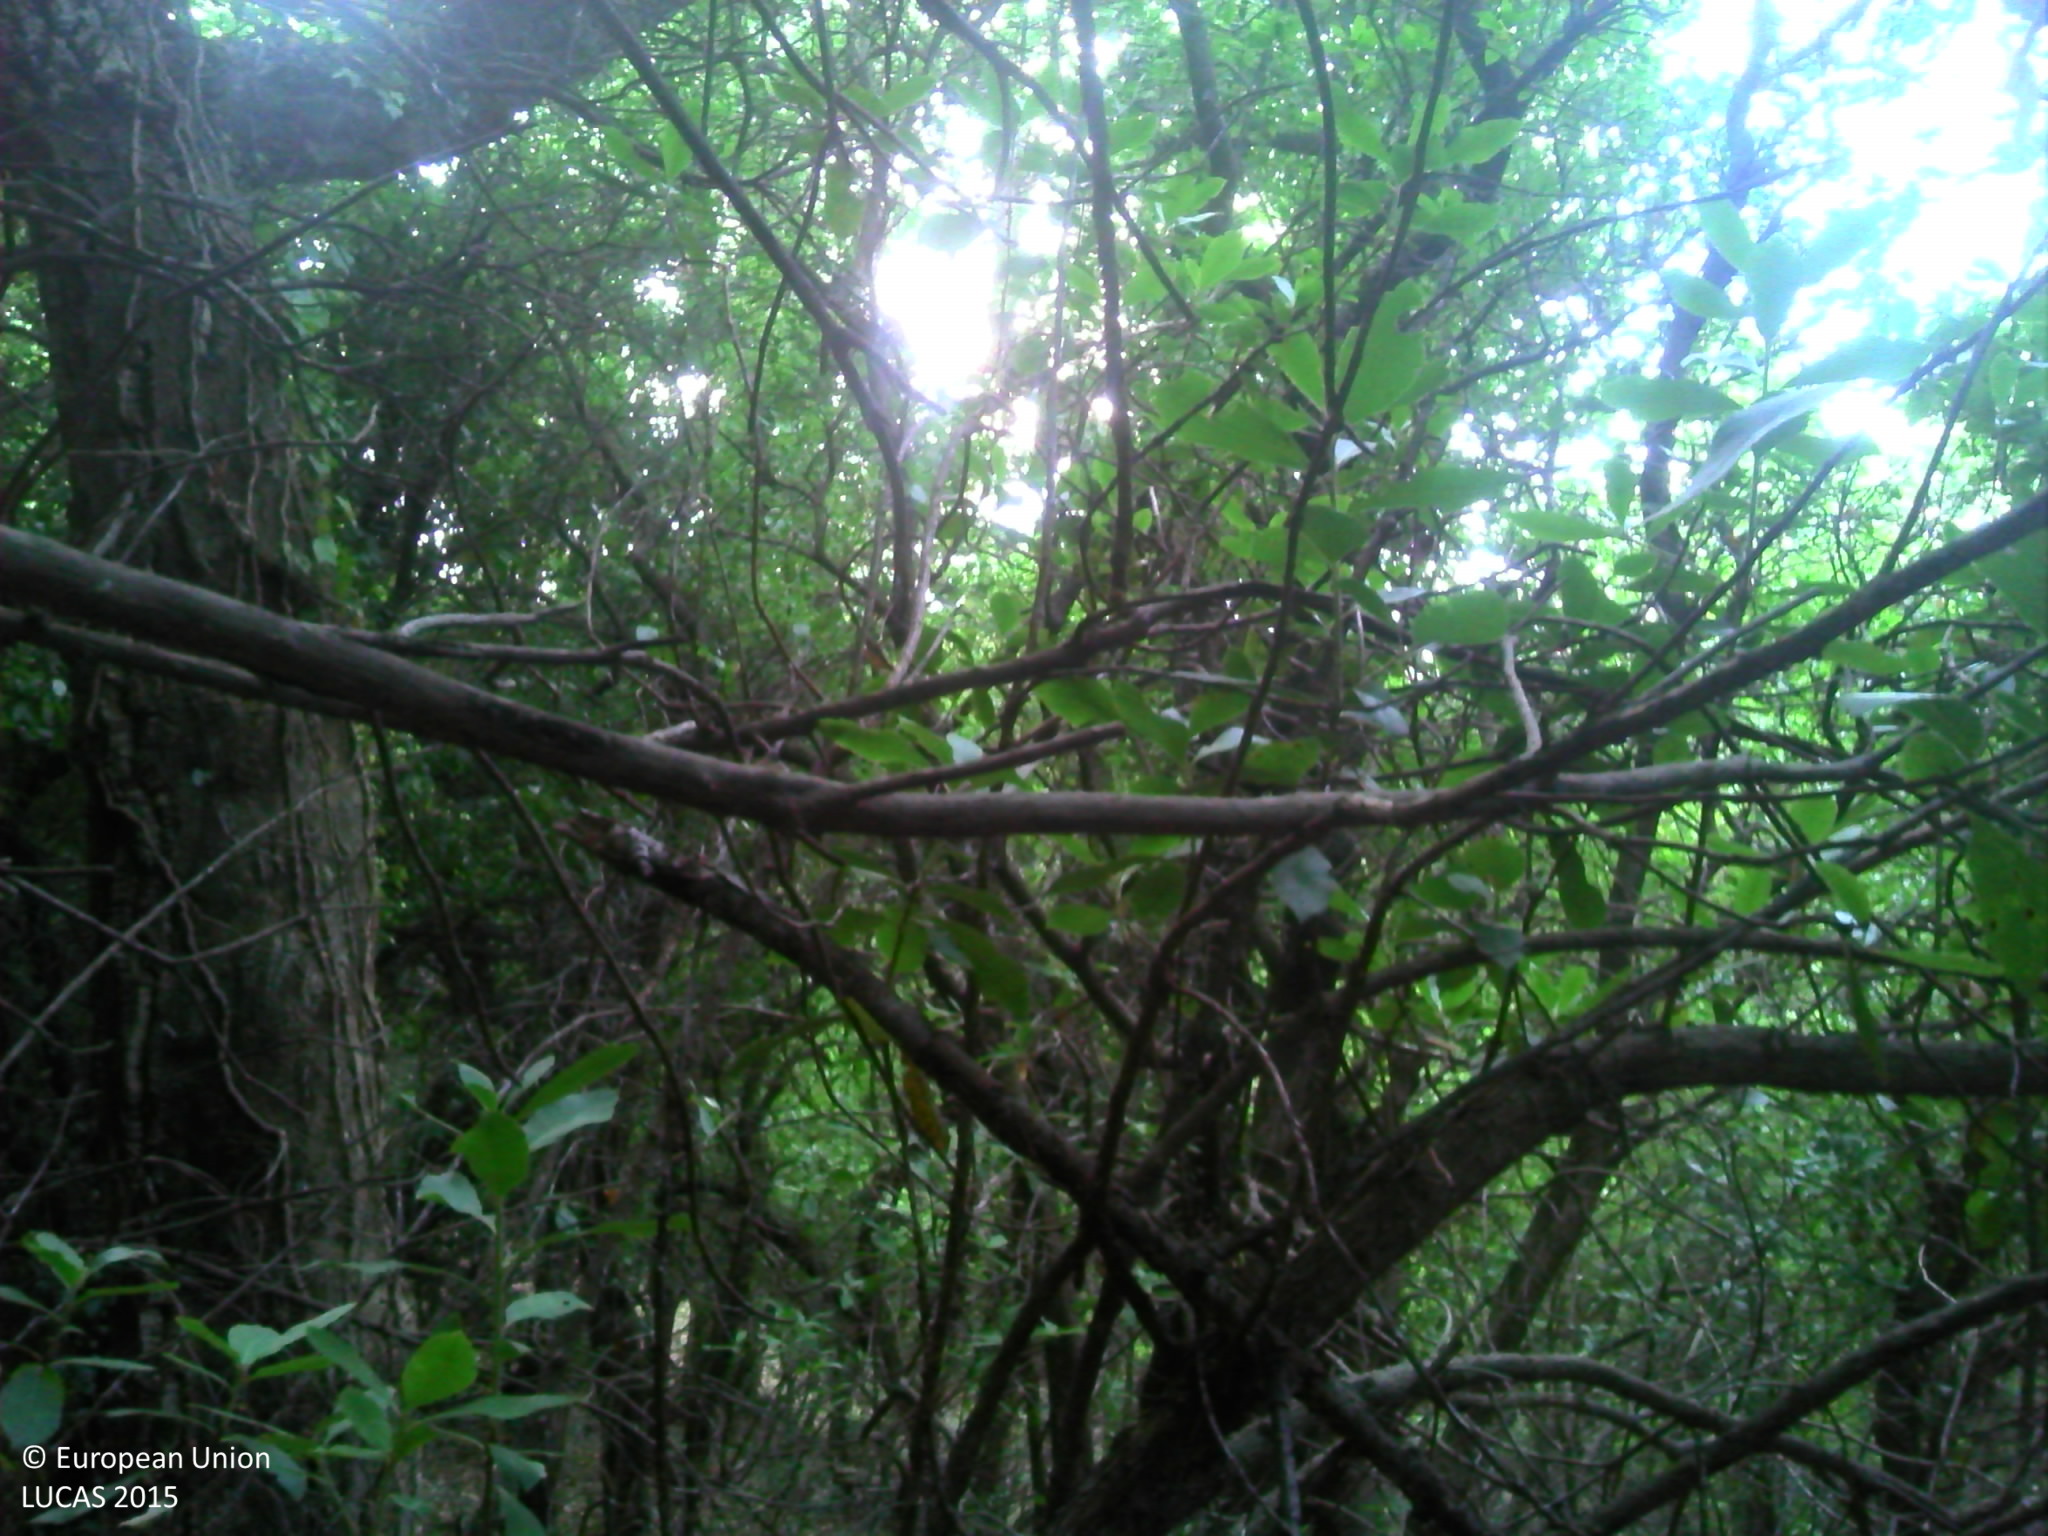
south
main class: Woodland
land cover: Broadleaved woodland
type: broadleaved evergreen forest
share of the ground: > 75 %
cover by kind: broadleaved forest trees 80 %, shrubs 20 %
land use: Semi-natural and natural areas not in use
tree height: > 5 m
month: July
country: FR
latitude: 43.2732
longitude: 6.3006
